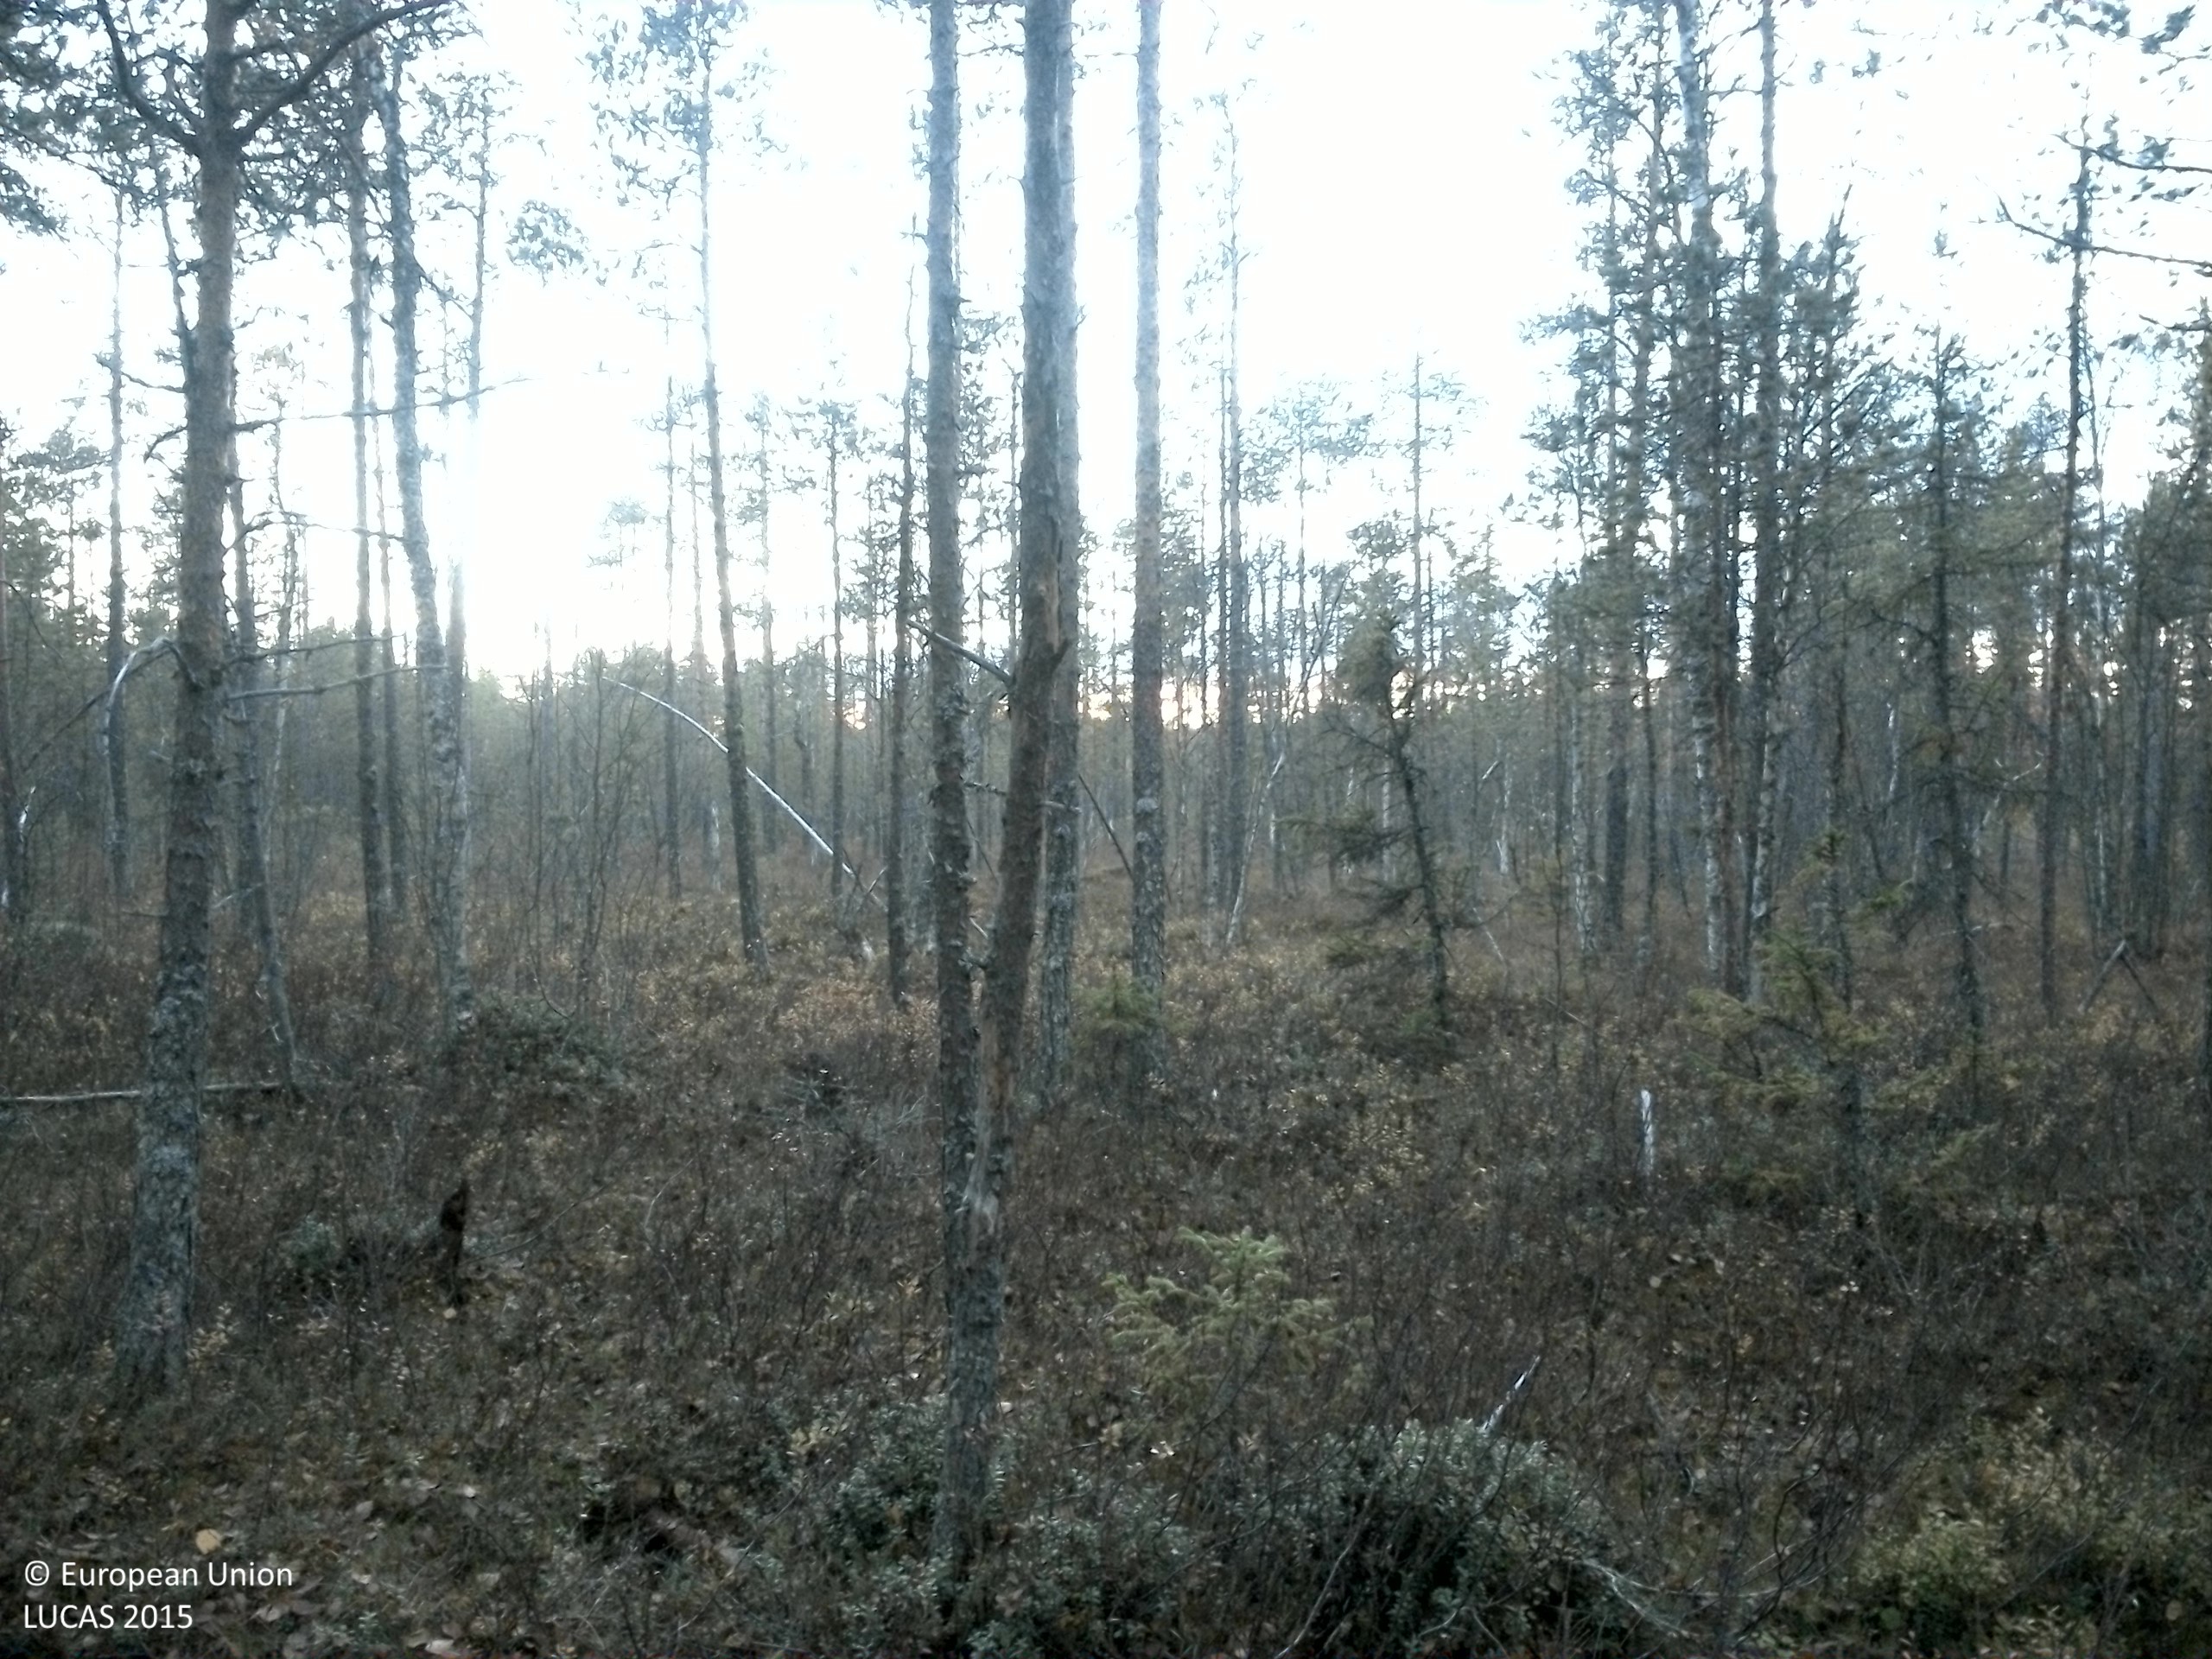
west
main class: Woodland
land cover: Pine dominated coniferous woodland
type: boreal forest
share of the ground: 25 - 50 %
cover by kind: shrubs 45 %, coniferous forest trees 35 %, broadleaved forest trees 10 %, lichens and mosses 10 %
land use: Forestry
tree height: > 5 m
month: September
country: SE
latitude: 64.2531
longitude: 16.3451
